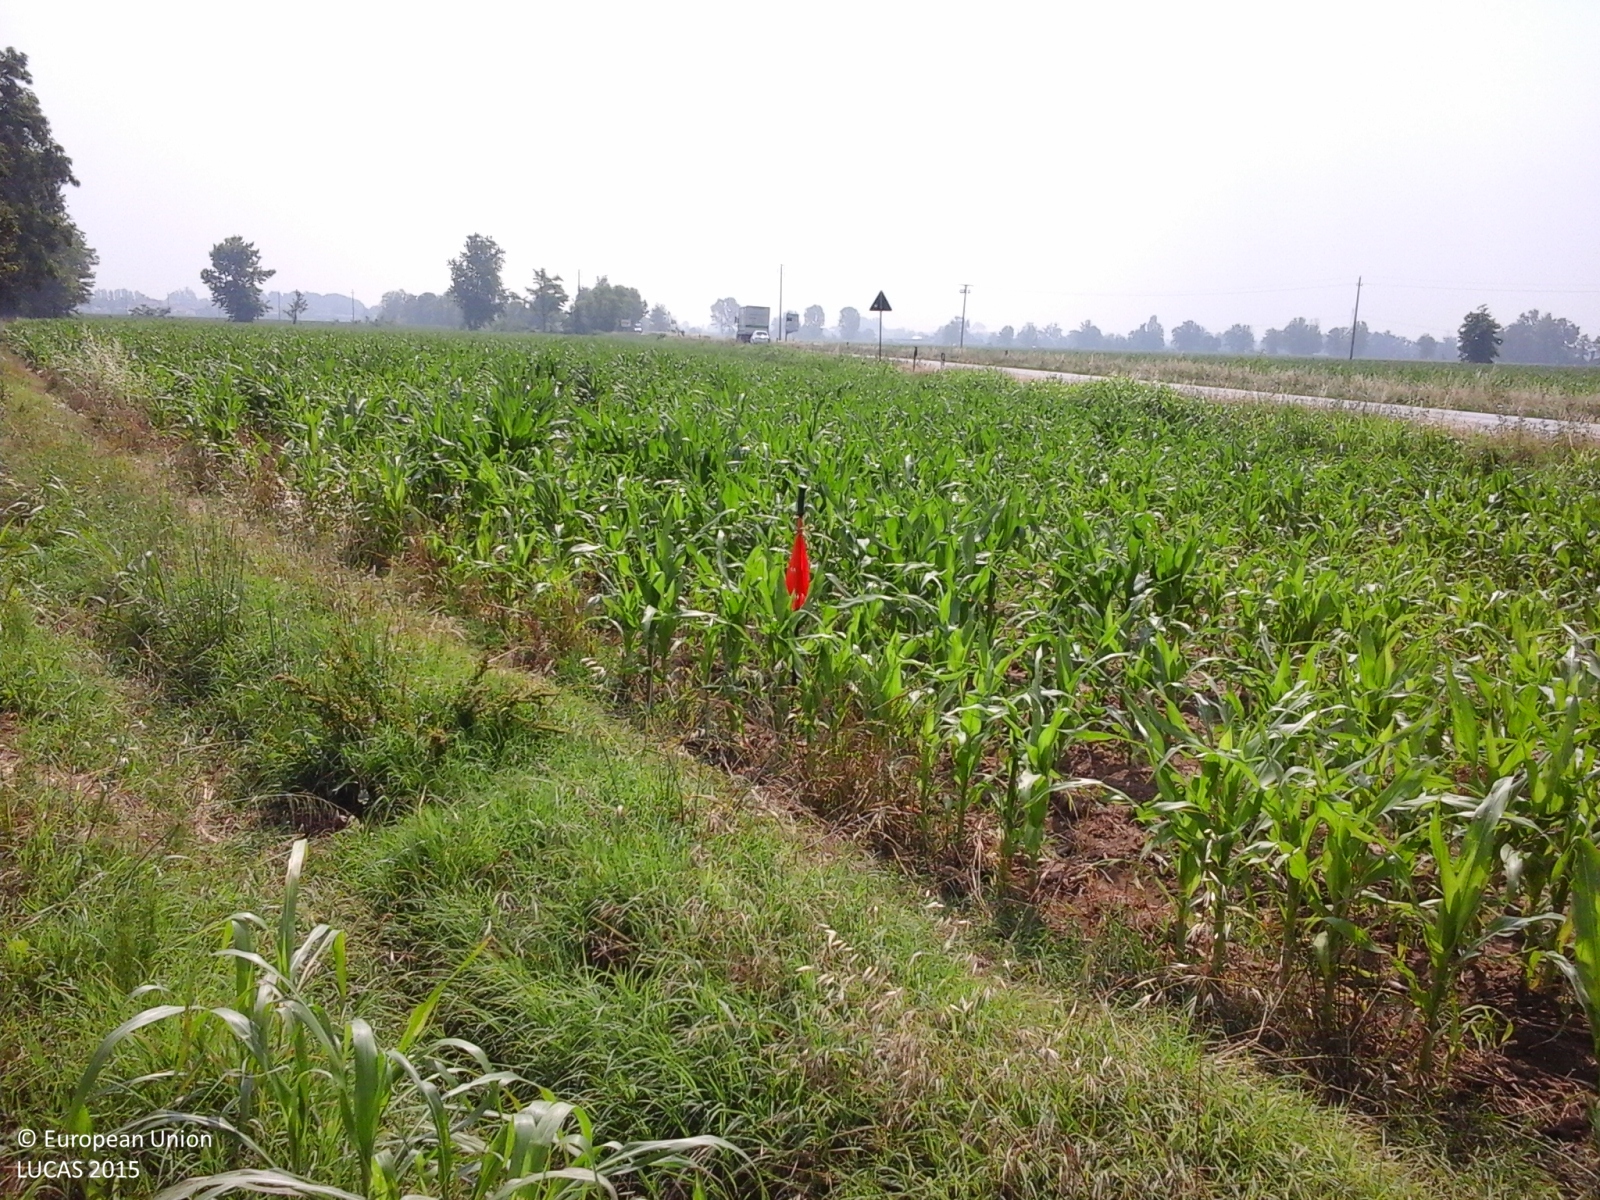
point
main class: Cropland
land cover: Maize
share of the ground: > 75 %
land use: Agriculture (excluding fallow land and kitchen gardens)
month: June
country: IT
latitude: 45.3782
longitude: 10.0637
